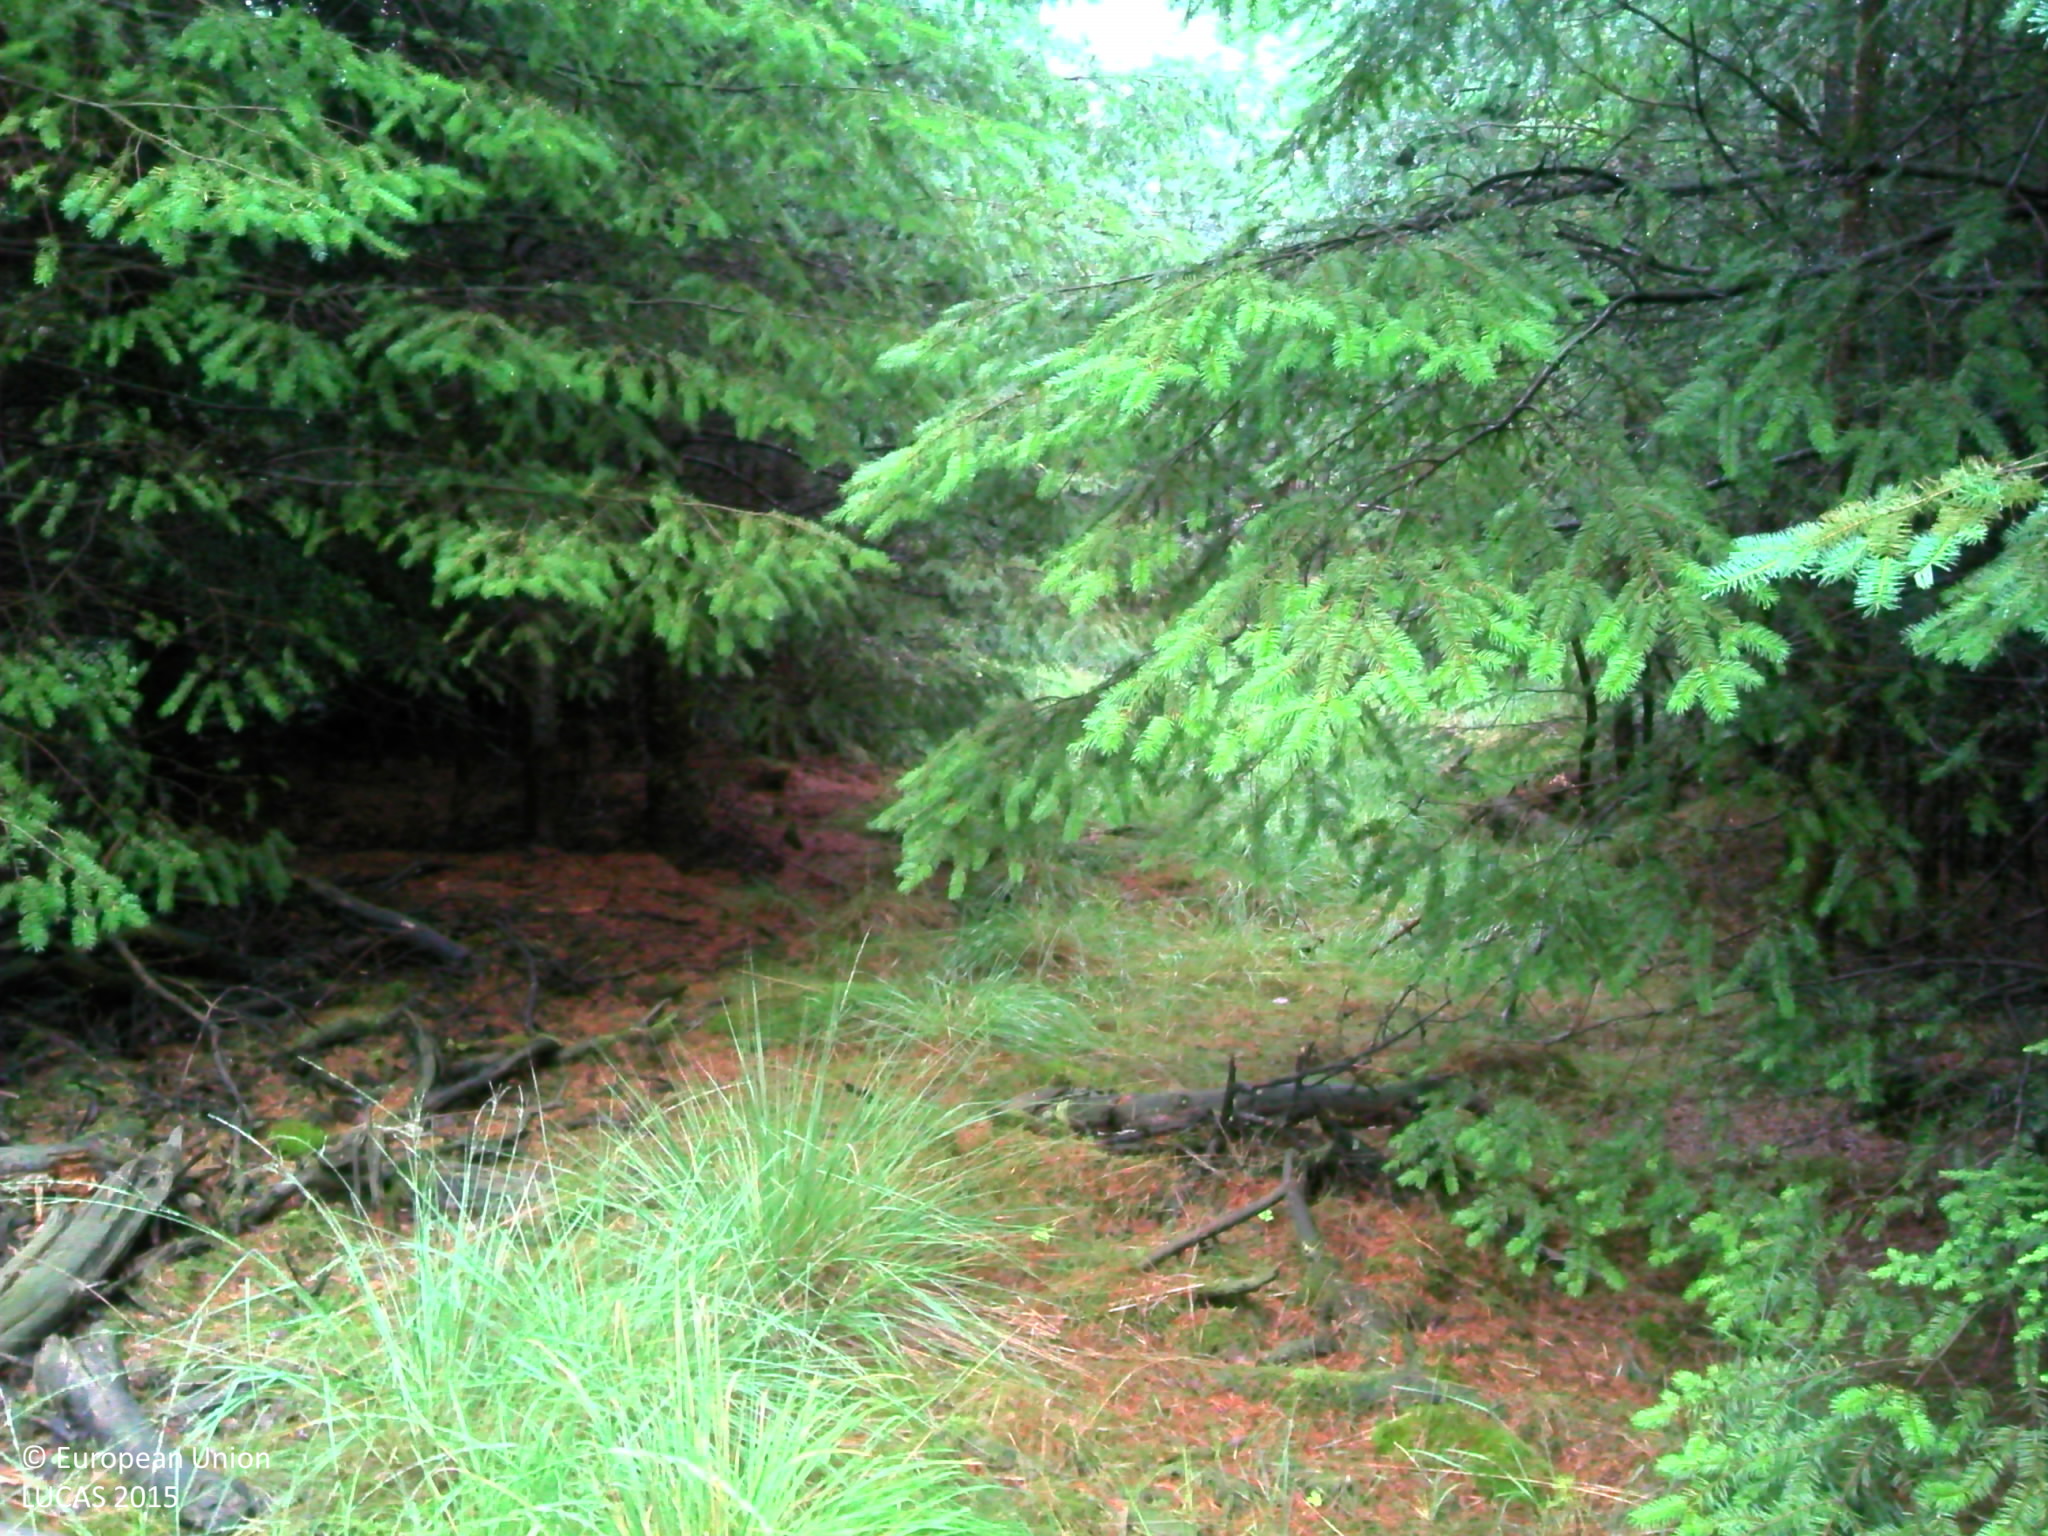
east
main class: Woodland
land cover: Other coniferous woodland
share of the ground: 50 - 75 %
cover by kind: coniferous forest trees 70 %, herbaceous plants 30 %
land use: Forestry
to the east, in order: Other coniferous woodland; Pine dominated coniferous woodland; Spontaneously vegetated surfaces; Tracks; Spontaneously vegetated surfaces; Pine dominated coniferous woodland
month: August
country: BE
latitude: 51.3579
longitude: 5.1003
